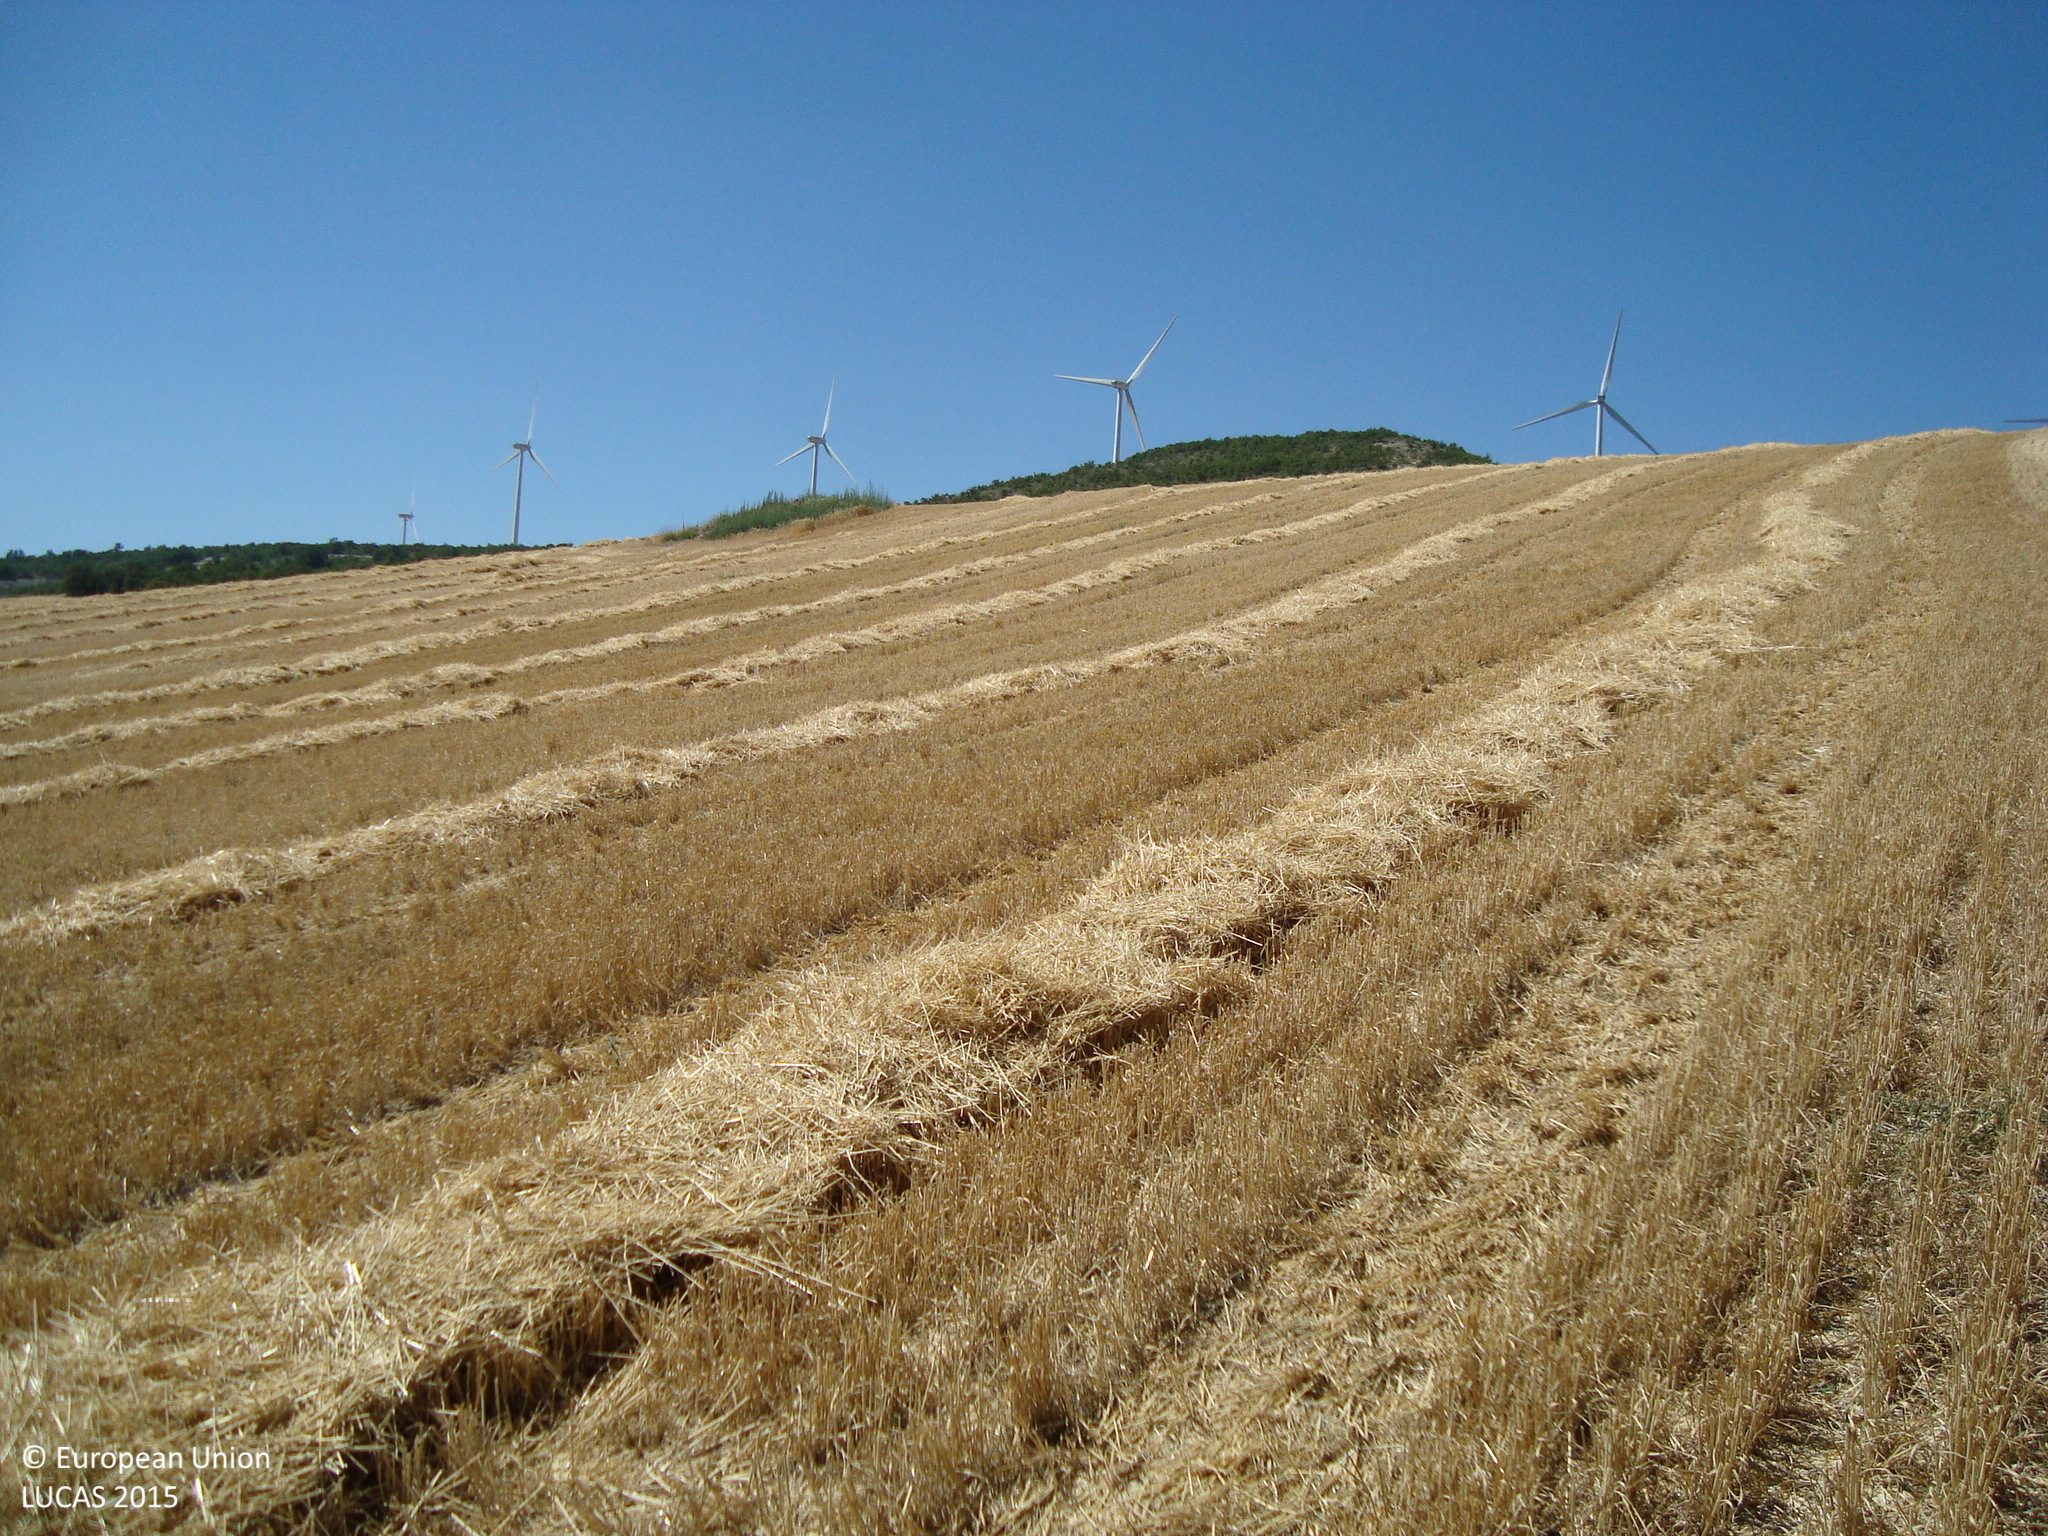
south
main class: Cropland
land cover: Common wheat
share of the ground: > 75 %
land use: Agriculture (excluding fallow land and kitchen gardens)
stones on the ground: 10 - 25 %
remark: Harvested field
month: July
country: ES
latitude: 42.0099
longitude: -4.2287
